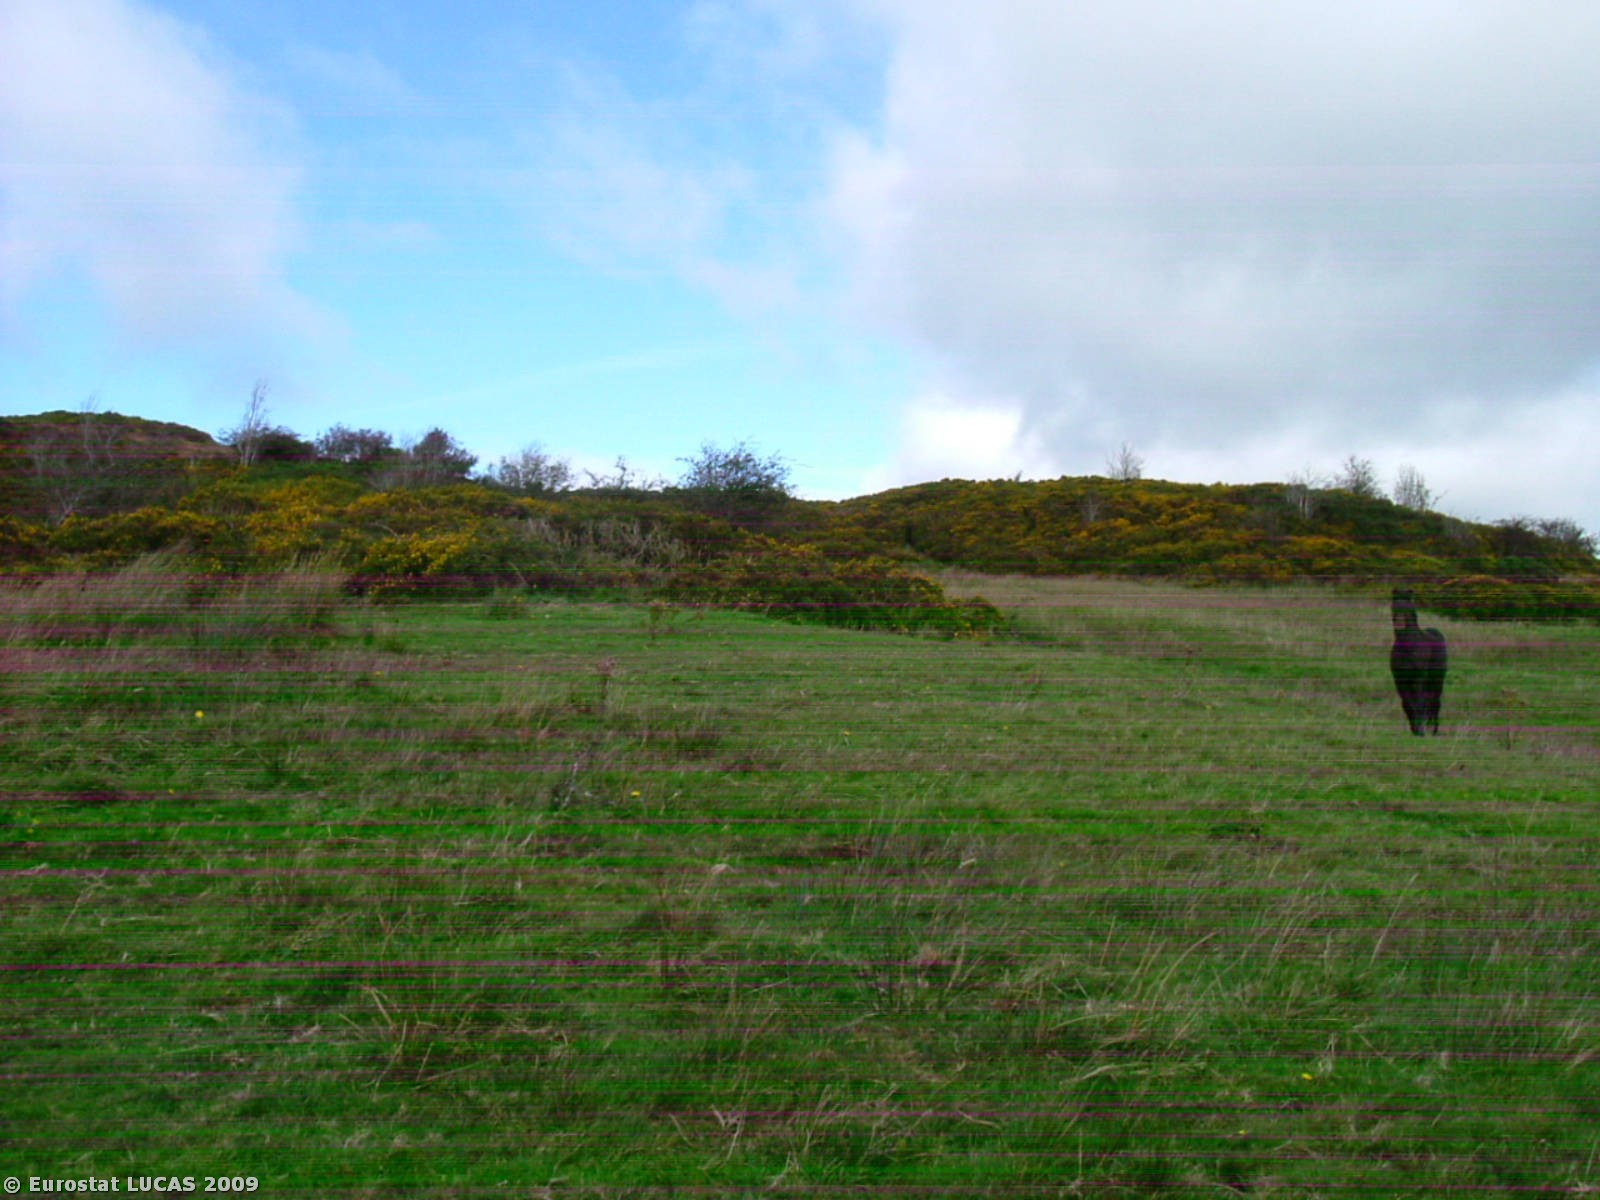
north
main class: Grassland
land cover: Grassland without tree/shrub cover
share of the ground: > 75 %
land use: Agriculture (excluding fallow land and kitchen gardens)
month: September
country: IE
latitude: 52.7637
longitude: -8.1885
